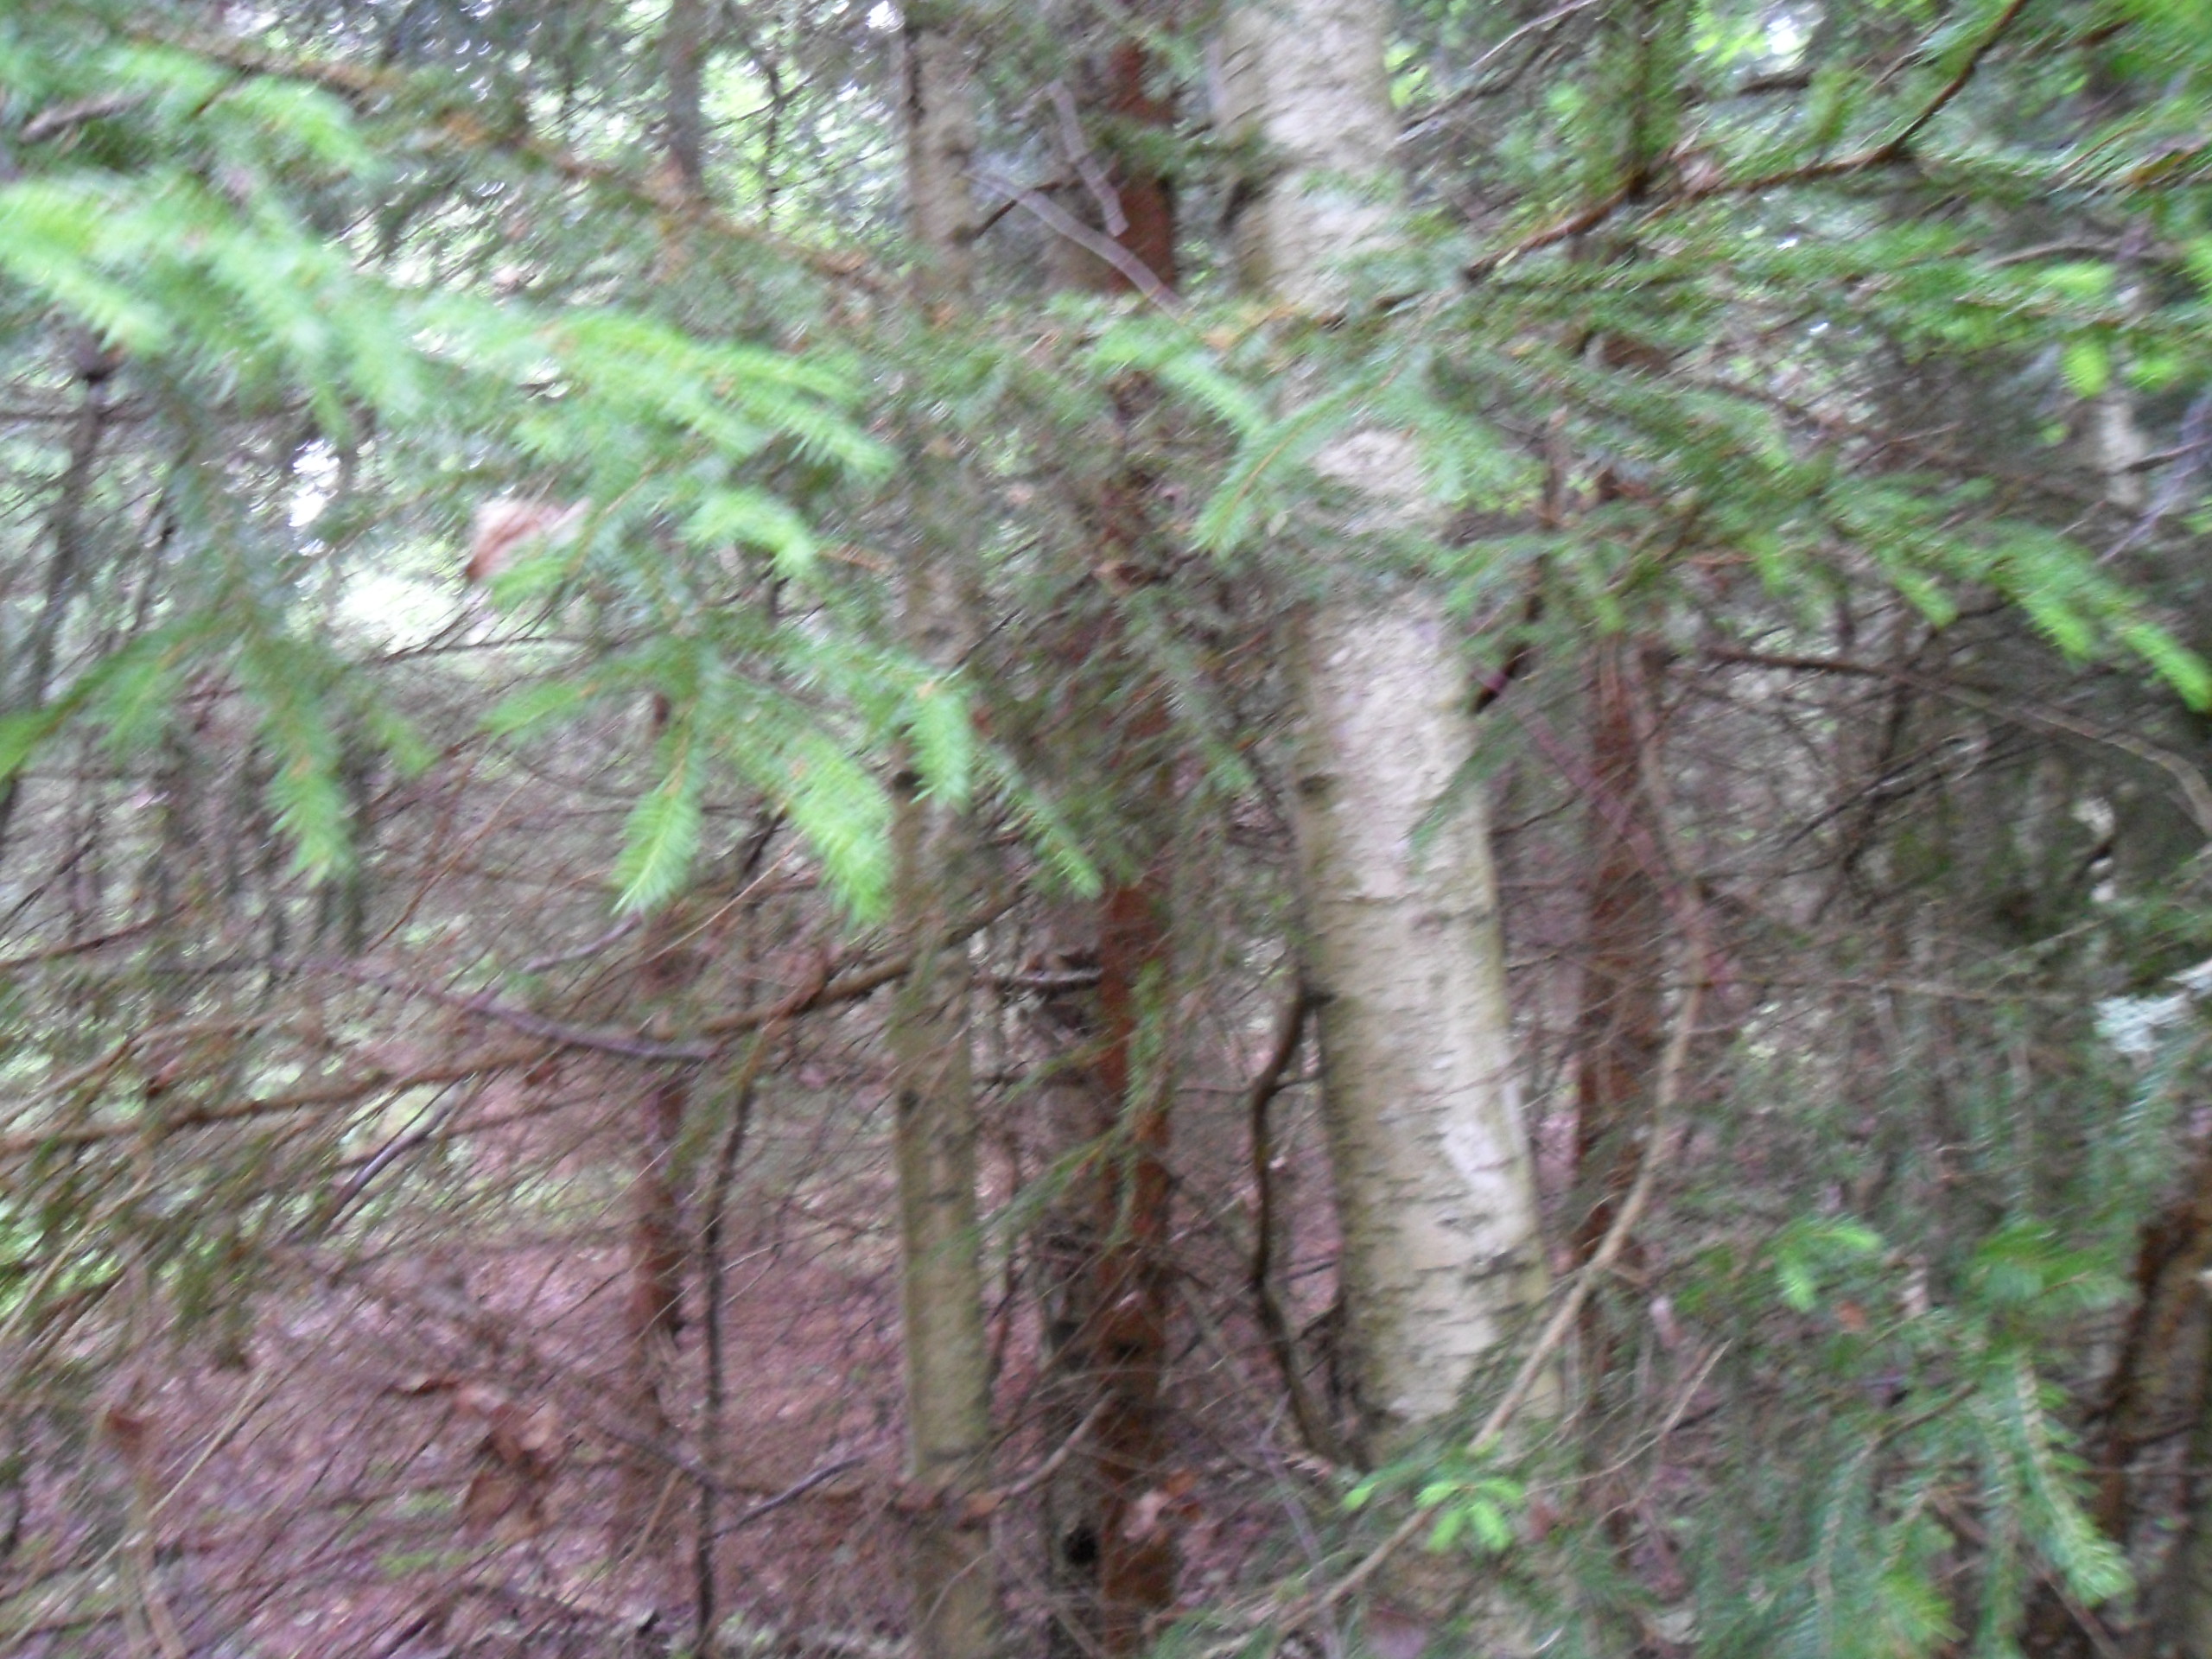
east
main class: Woodland
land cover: Spruce dominated mixed woodland
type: hemiboreal forest and nemoral coniferous forest and mixed broadleaved-coniferous forest
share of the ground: > 75 %
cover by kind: coniferous forest trees 50 %, broadleaved forest trees 30 %, herbaceous plants 20 %
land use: Forestry
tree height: > 5 m
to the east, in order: Spruce dominated mixed woodland; Ditches and canals; Spruce dominated mixed woodland; Other coniferous woodland
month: June
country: LV
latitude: 57.3935
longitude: 21.9414
